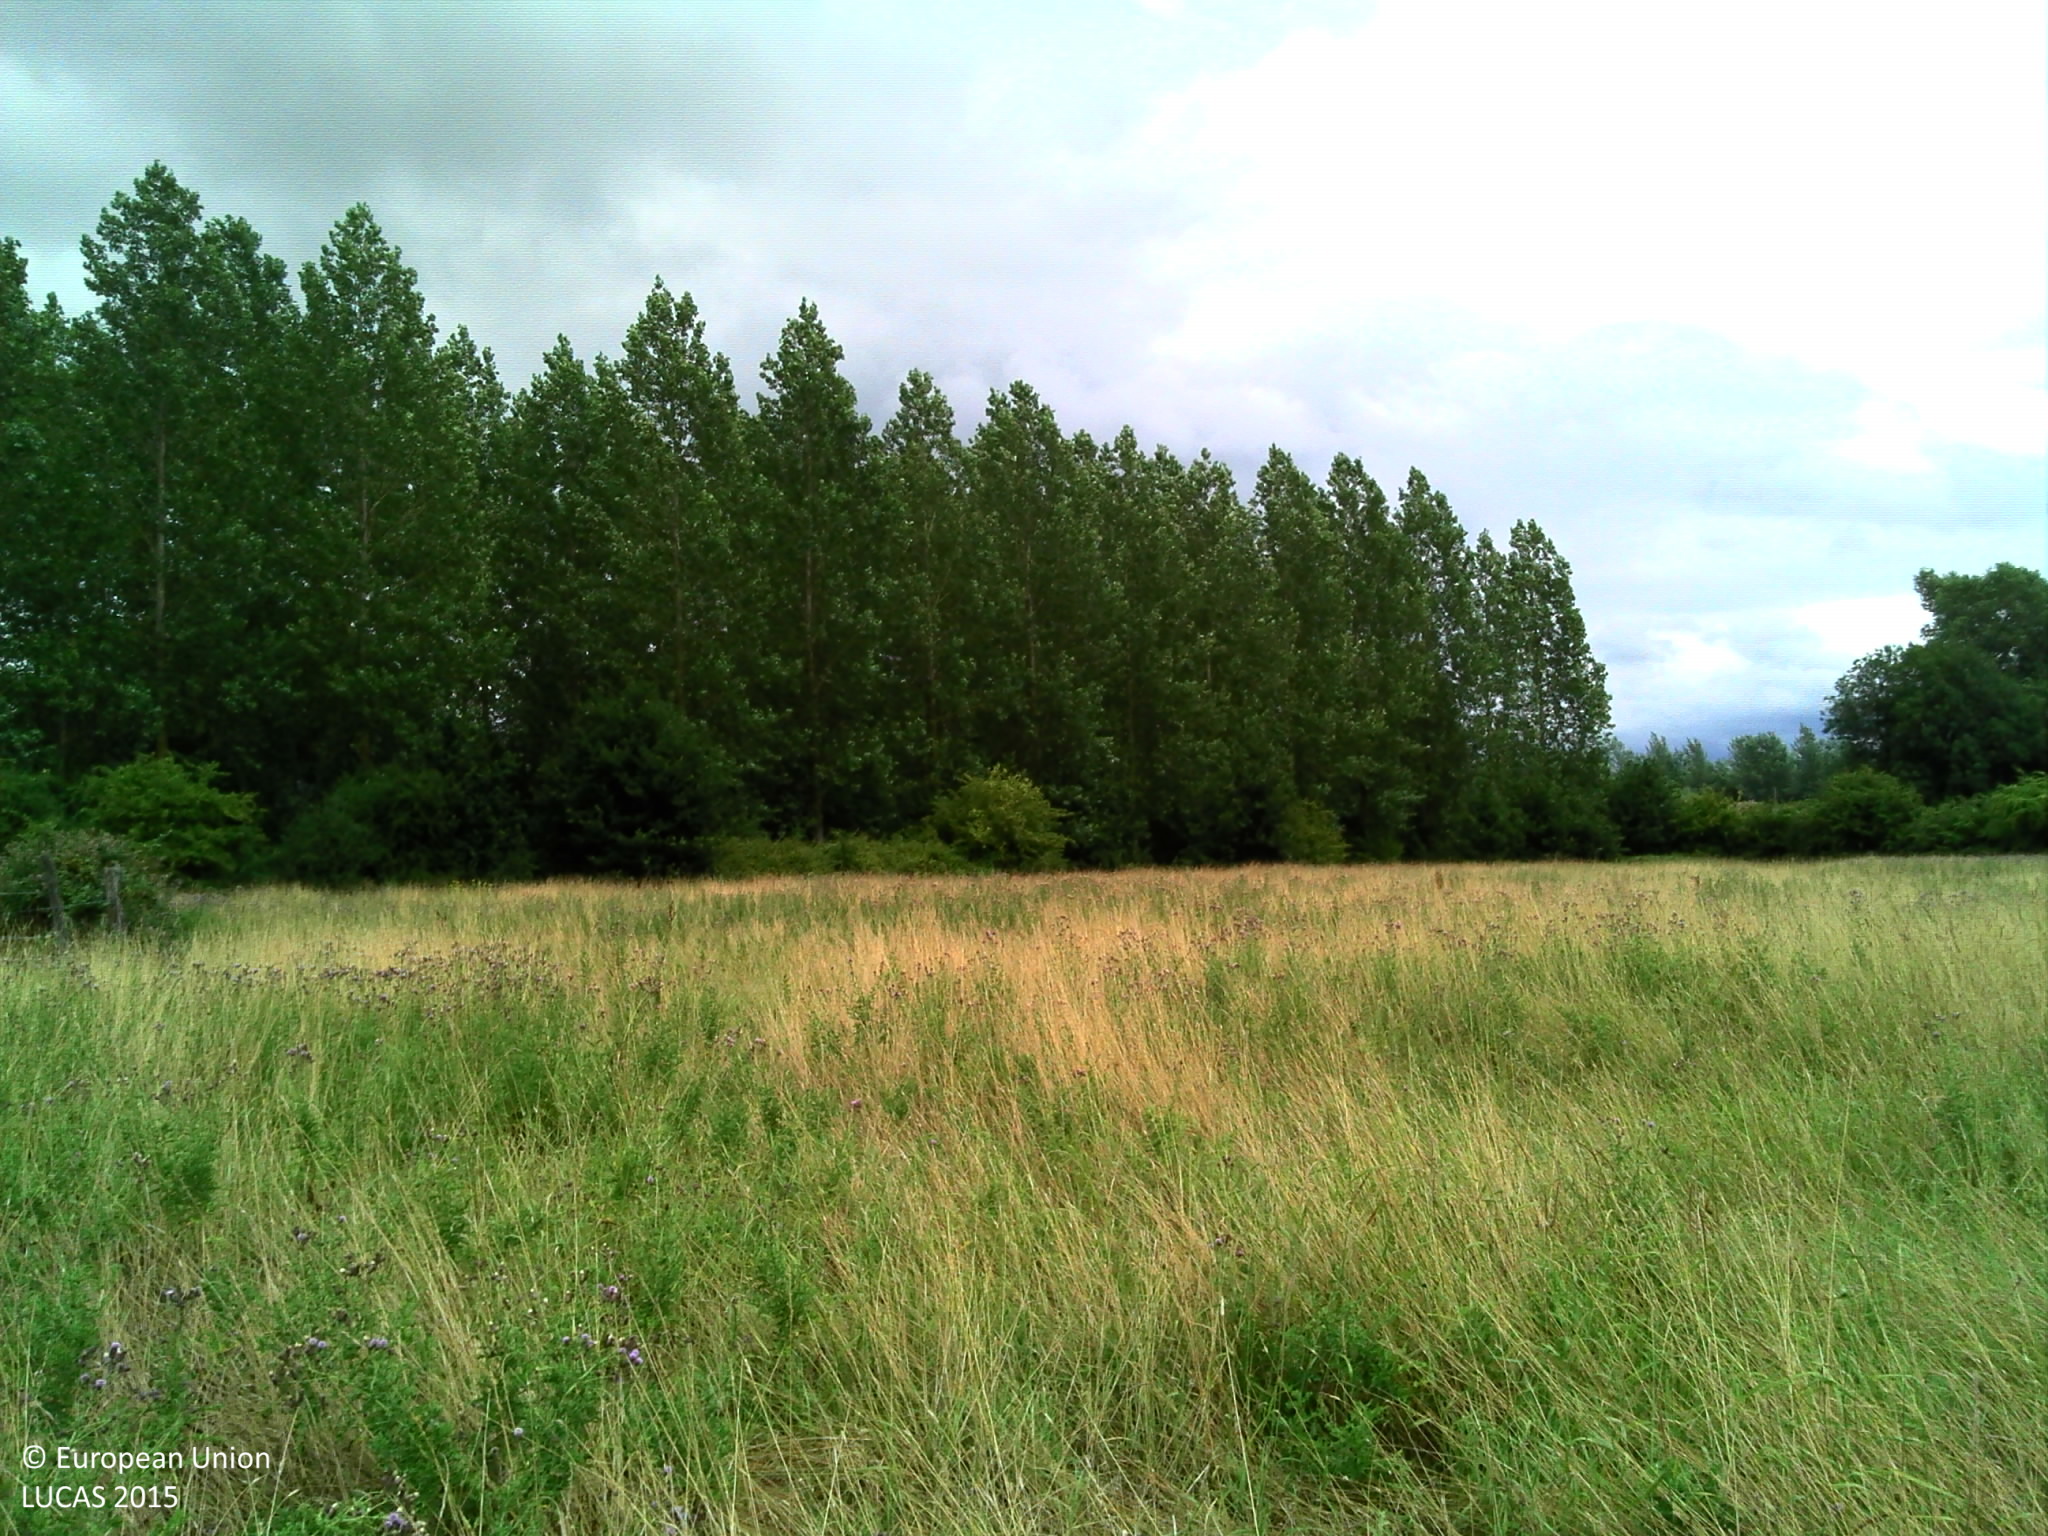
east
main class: Grassland
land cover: Grassland without tree/shrub cover
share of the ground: > 75 %
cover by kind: herbaceous plants 95 %, shrubs 5 %
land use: Agriculture (excluding fallow land and kitchen gardens)
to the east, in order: Grassland without tree/shrub cover; Fences; Broadleaved woodland; Fences; Grassland without tree/shrub cover; Fences; Broadleaved woodland; Fences; Grassland without tree/shrub cover
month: July
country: BE
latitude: 50.8713
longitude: 5.0947
